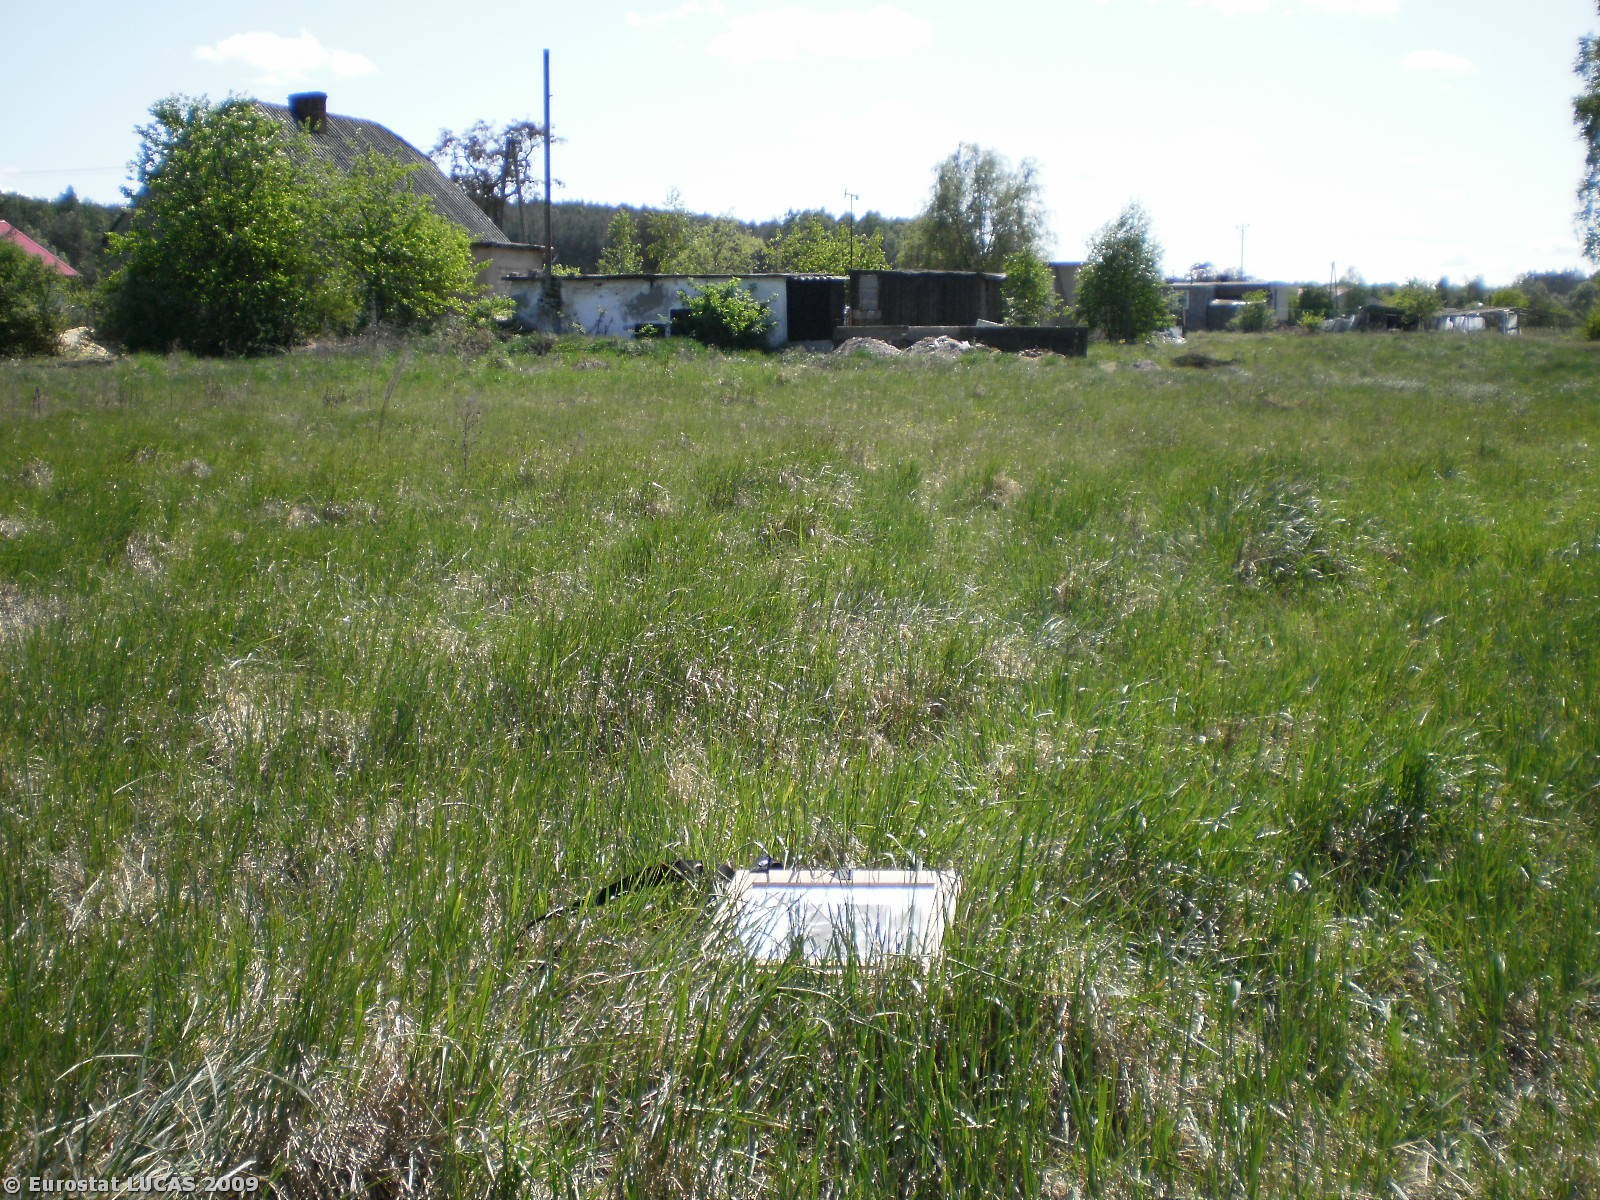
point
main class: Grassland
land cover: Grassland without tree/shrub cover
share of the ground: > 75 %
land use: Agriculture (excluding fallow land and kitchen gardens)
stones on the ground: < 10 %
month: May
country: PL
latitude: 53.4943
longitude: 18.8389
